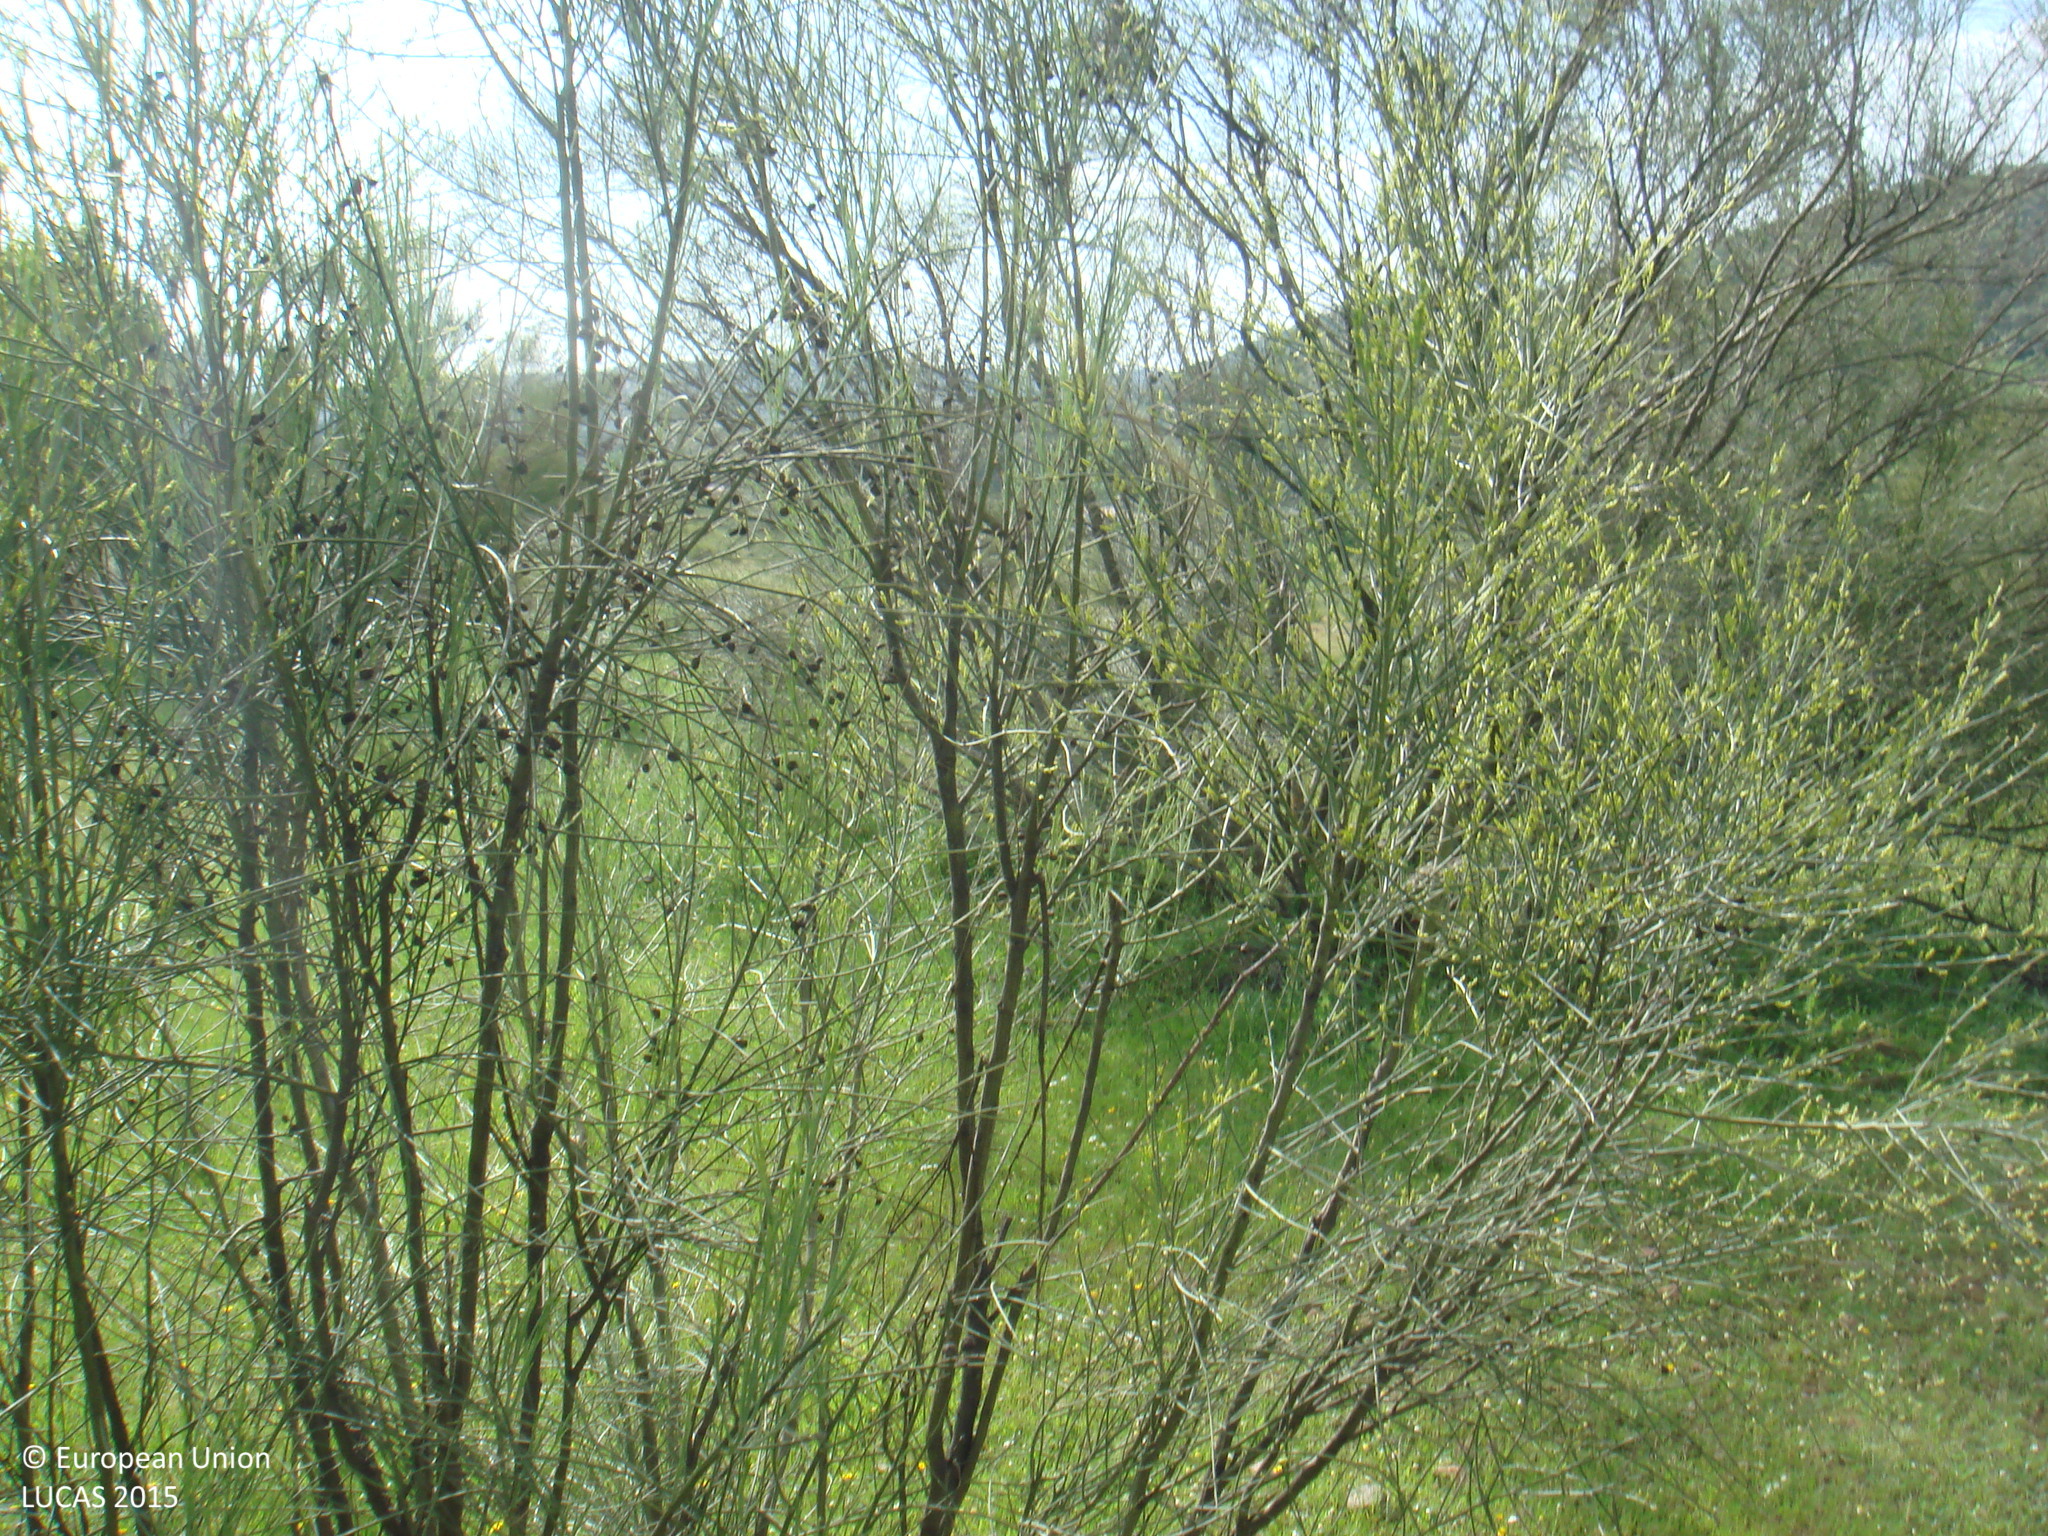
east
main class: Shrubland
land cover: Shrubland without tree cover
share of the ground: 25 - 50 %
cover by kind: herbaceous plants 70 %, shrubs 30 %
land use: Agriculture (excluding fallow land and kitchen gardens)
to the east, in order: Shrubland without tree cover; Fences; Grassland without tree/shrub cover; Paved roads, cycling and walking lanes; Grassland without tree/shrub cover; Electric lines; Spontaneously vegetated surfaces; Fences; Olive groves; Fences; Spontaneously vegetated surfaces; Tracks; Single bushes/trees; Common wheat; Spontaneously vegetated surfaces
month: April
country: ES
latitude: 38.2174
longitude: -5.2752
